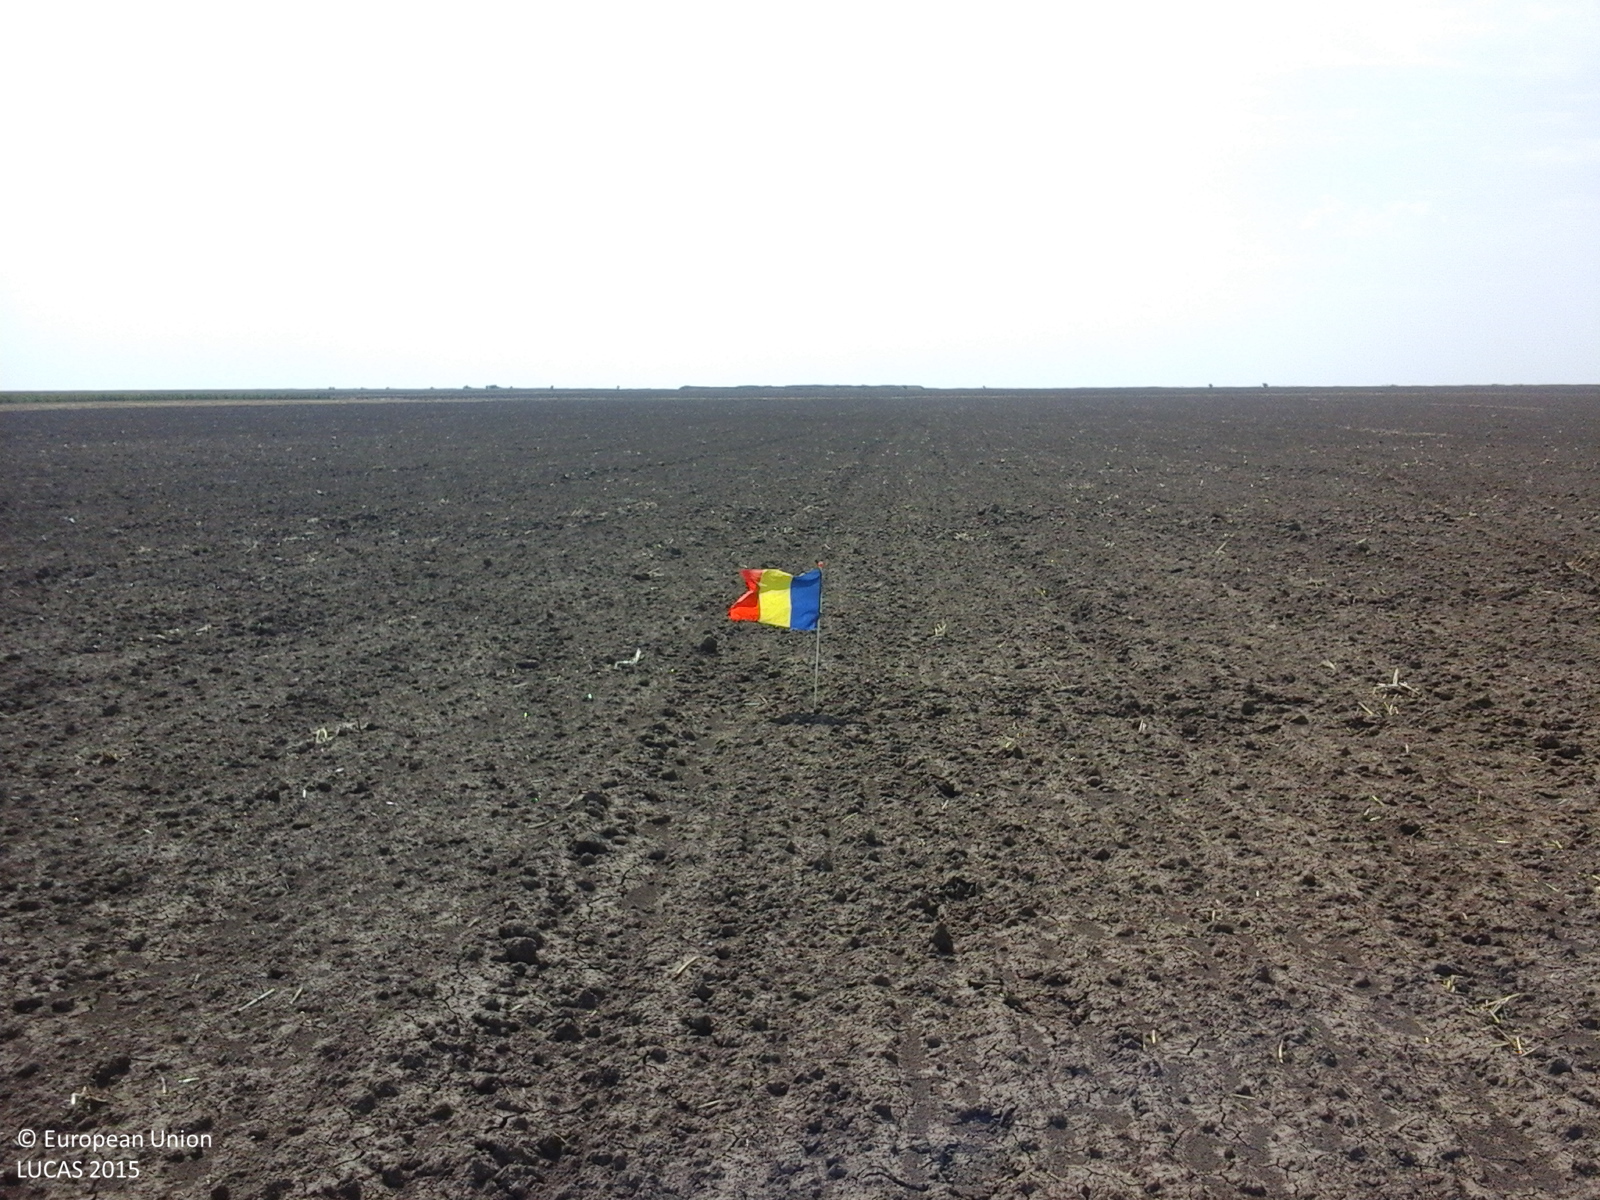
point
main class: Cropland
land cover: Common wheat
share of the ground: < 10 %
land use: Agriculture (excluding fallow land and kitchen gardens)
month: August
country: RO
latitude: 43.8836
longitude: 28.4227
